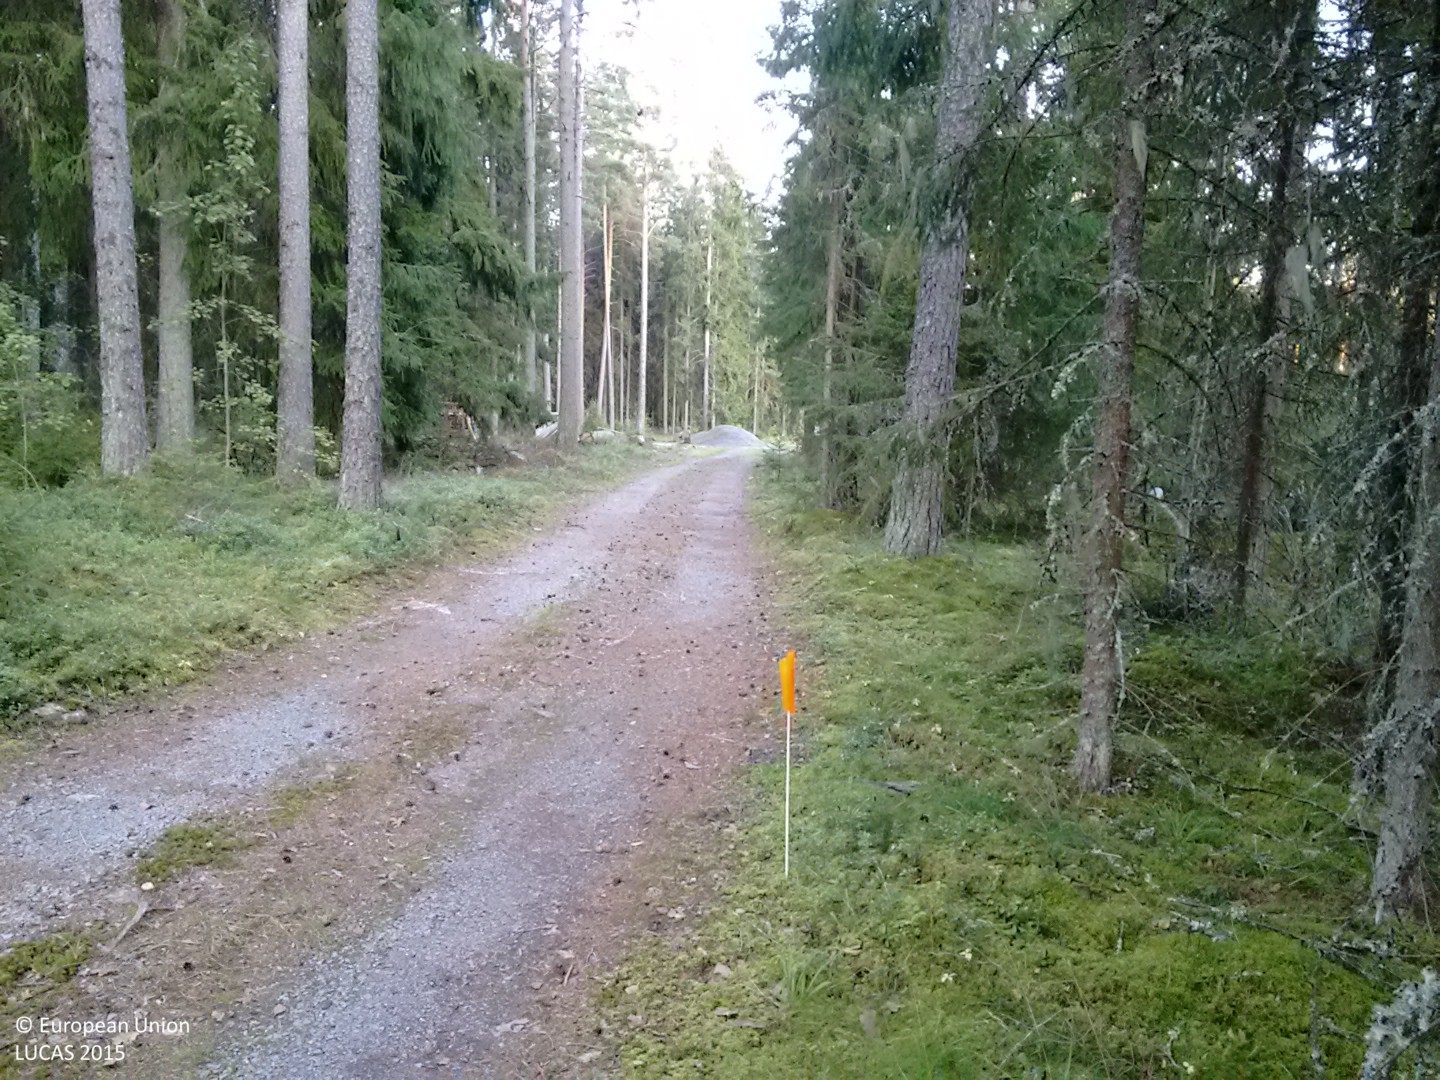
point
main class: Woodland
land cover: Spruce dominated coniferous woodland
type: hemiboreal forest and nemoral coniferous forest and mixed broadleaved-coniferous forest
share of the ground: > 75 %
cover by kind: coniferous forest trees 70 %, shrubs 15 %, herbaceous plants 10 %, broadleaved forest trees 5 %
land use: Forestry
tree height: > 5 m
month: September
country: FI
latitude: 60.9051
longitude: 21.8017
